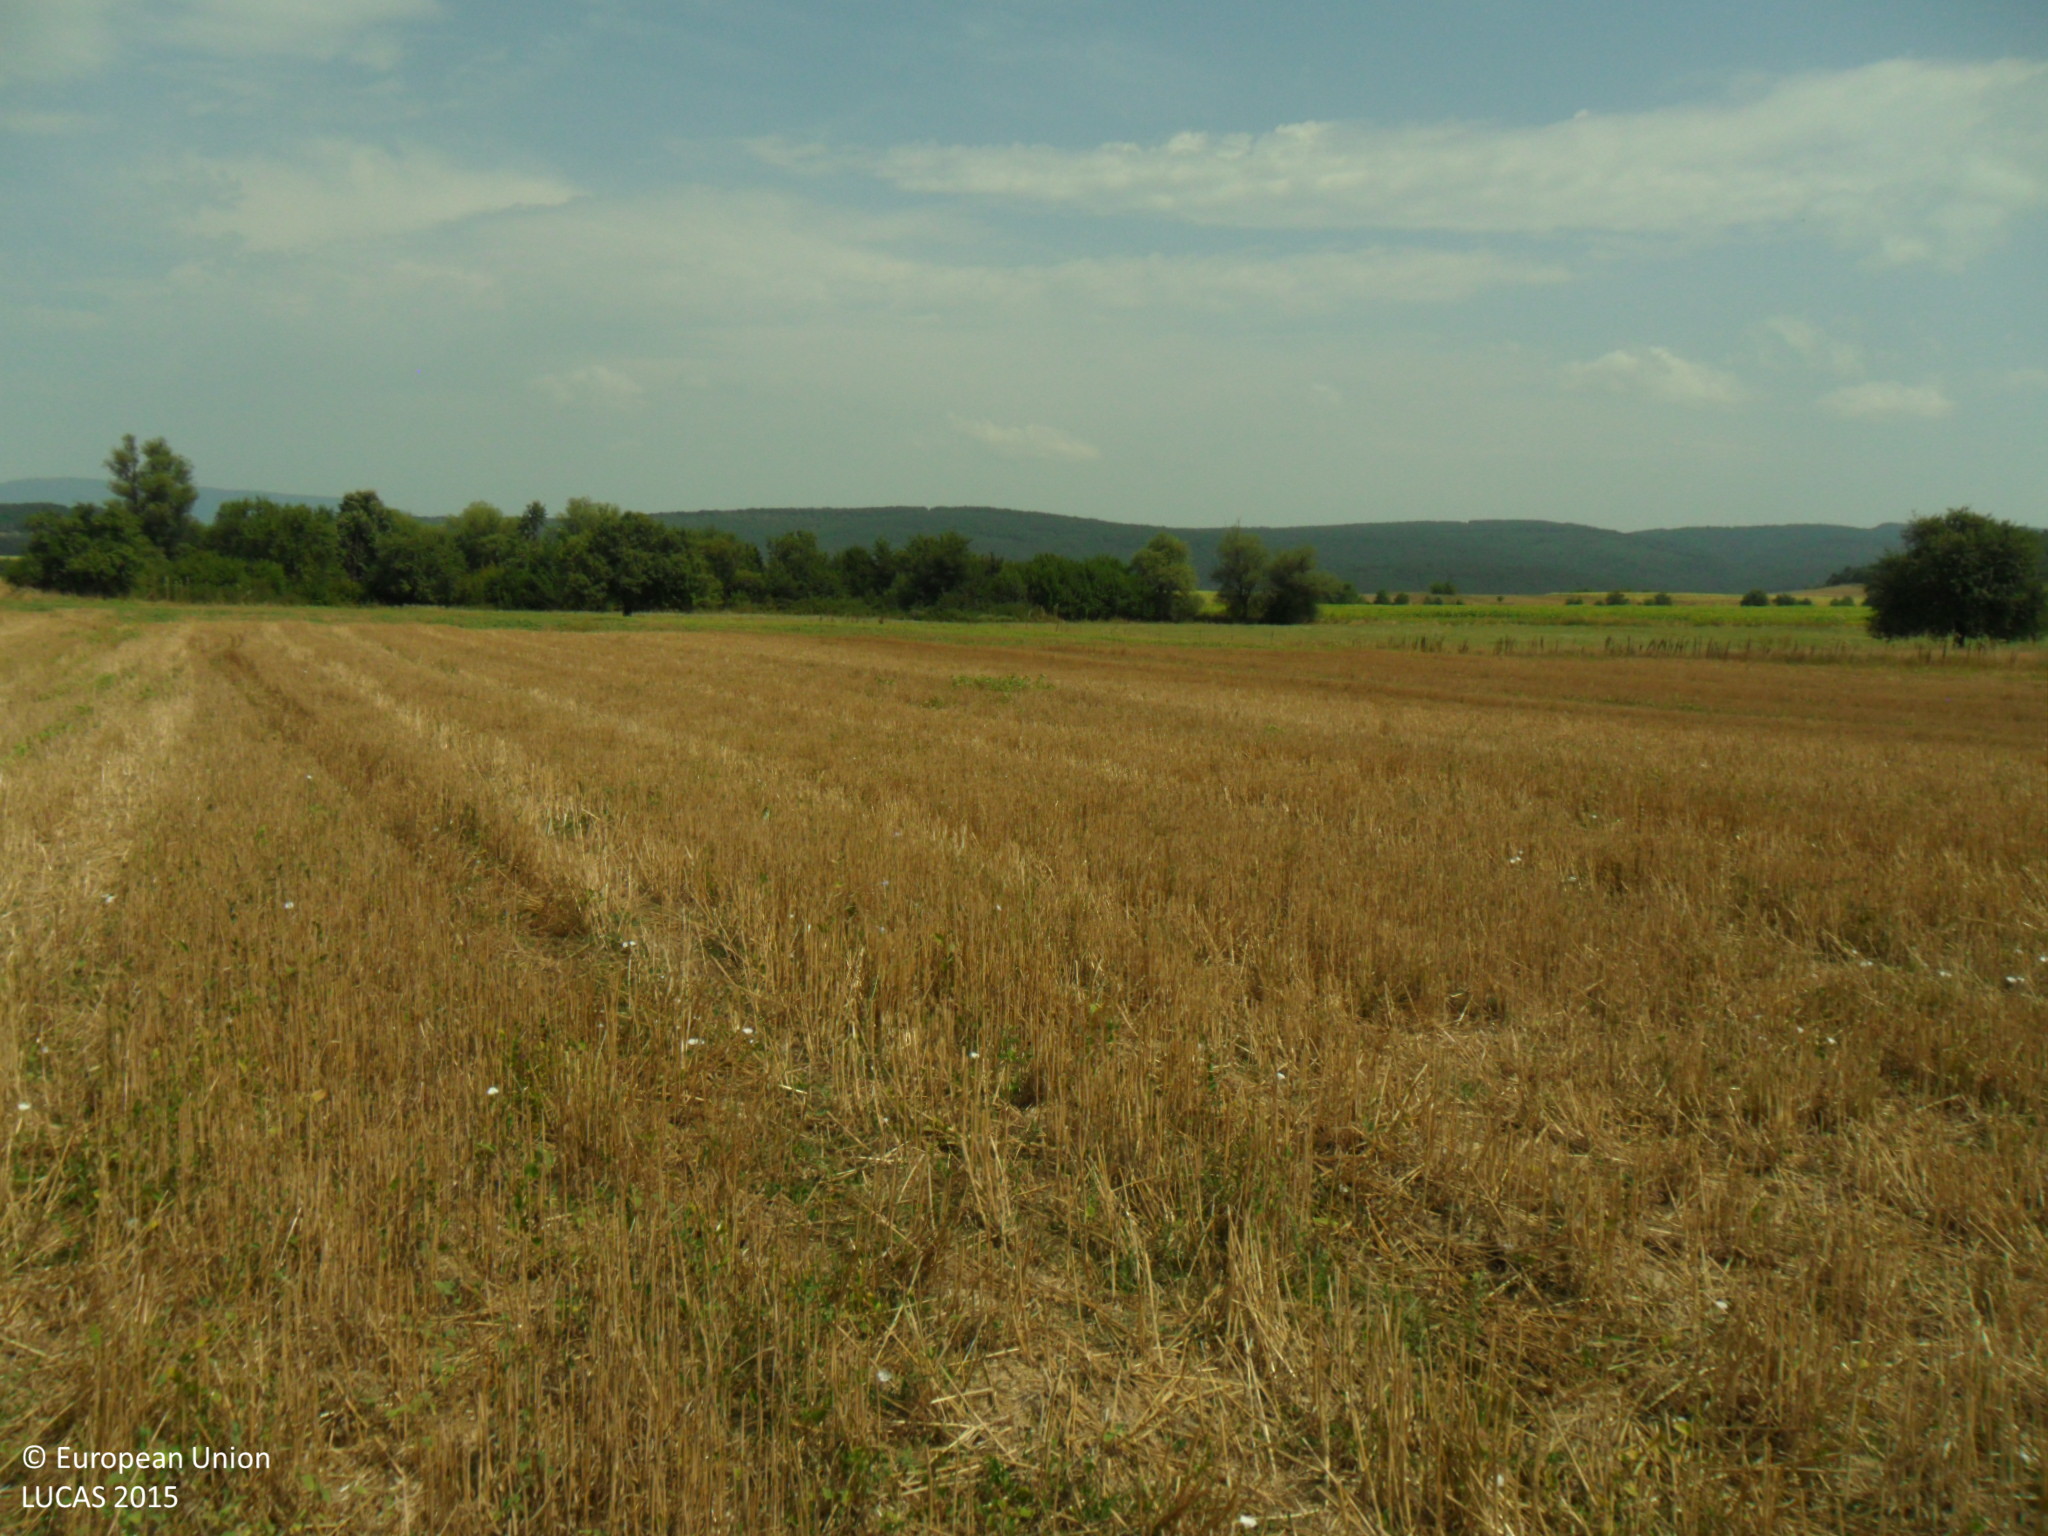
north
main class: Cropland
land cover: Common wheat
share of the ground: > 75 %
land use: Agriculture (excluding fallow land and kitchen gardens)
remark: Harvested field
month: August
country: BG
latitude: 43.0092
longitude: 26.7786
